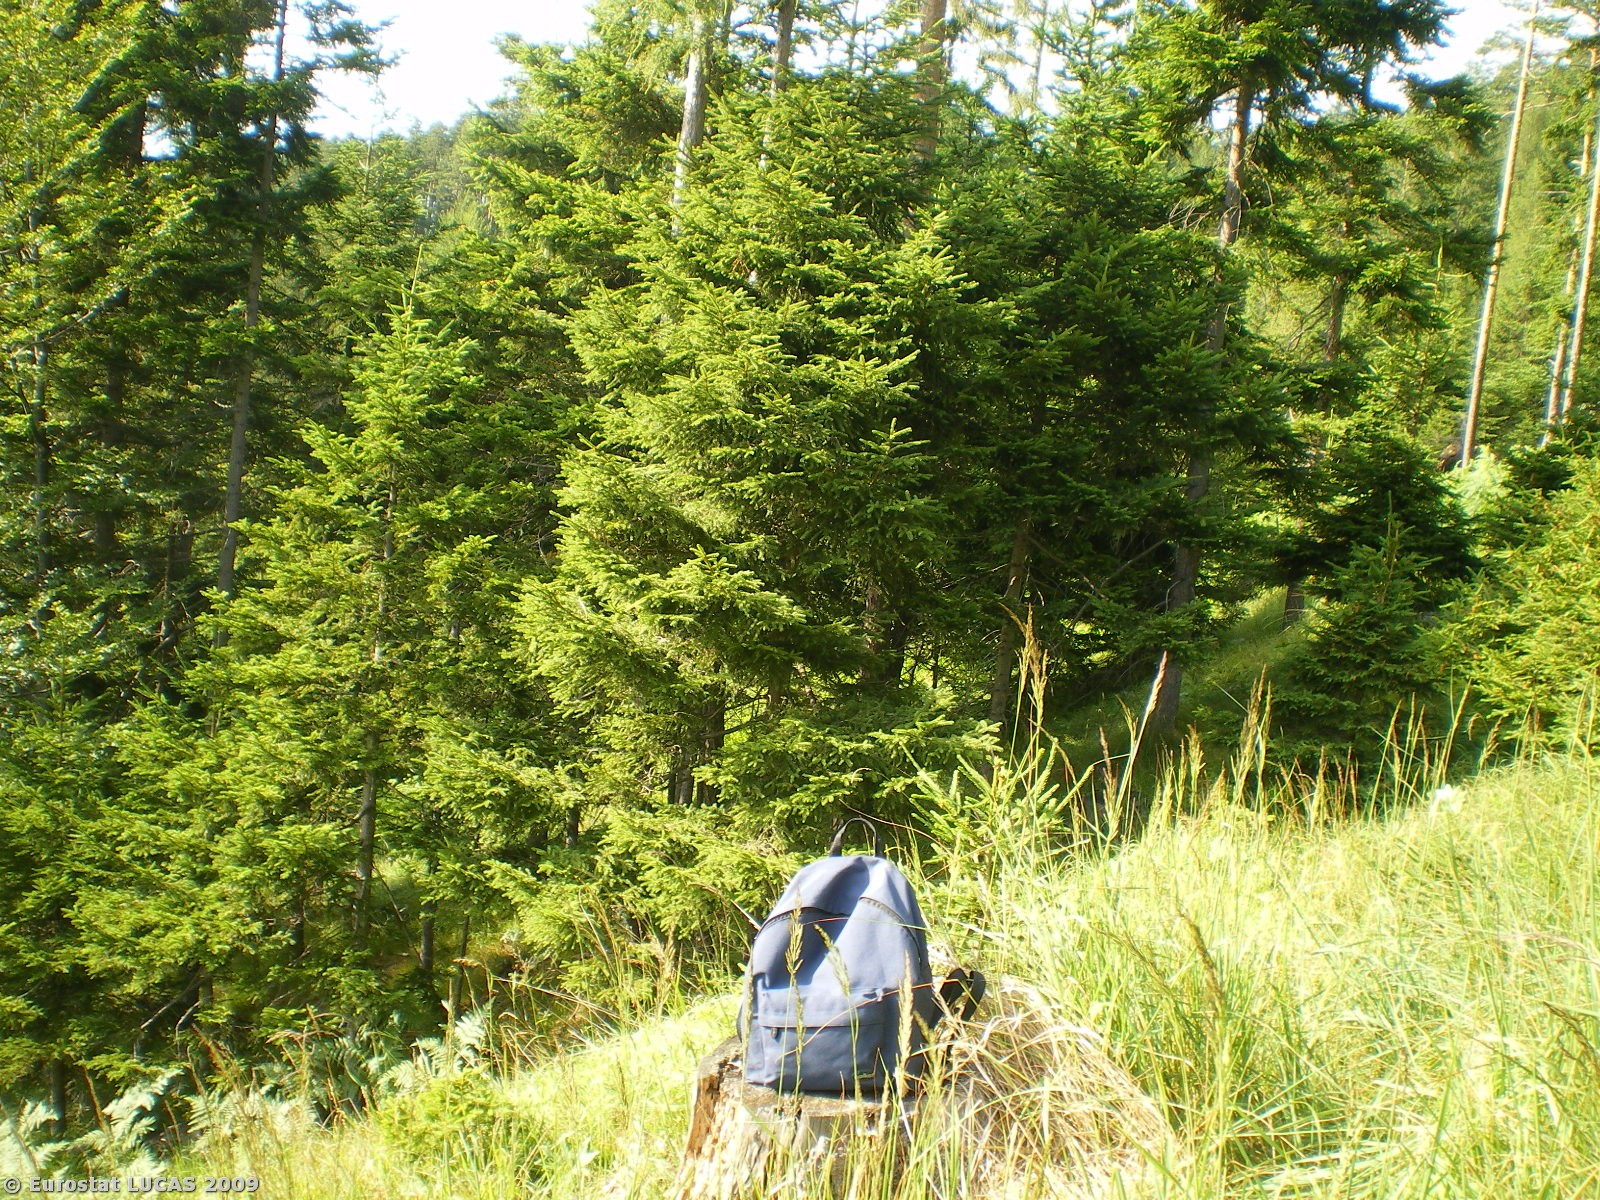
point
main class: Woodland
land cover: Coniferous woodland
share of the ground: 25 - 50 %
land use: Forestry
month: July
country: AT
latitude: 47.8549
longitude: 15.7896
